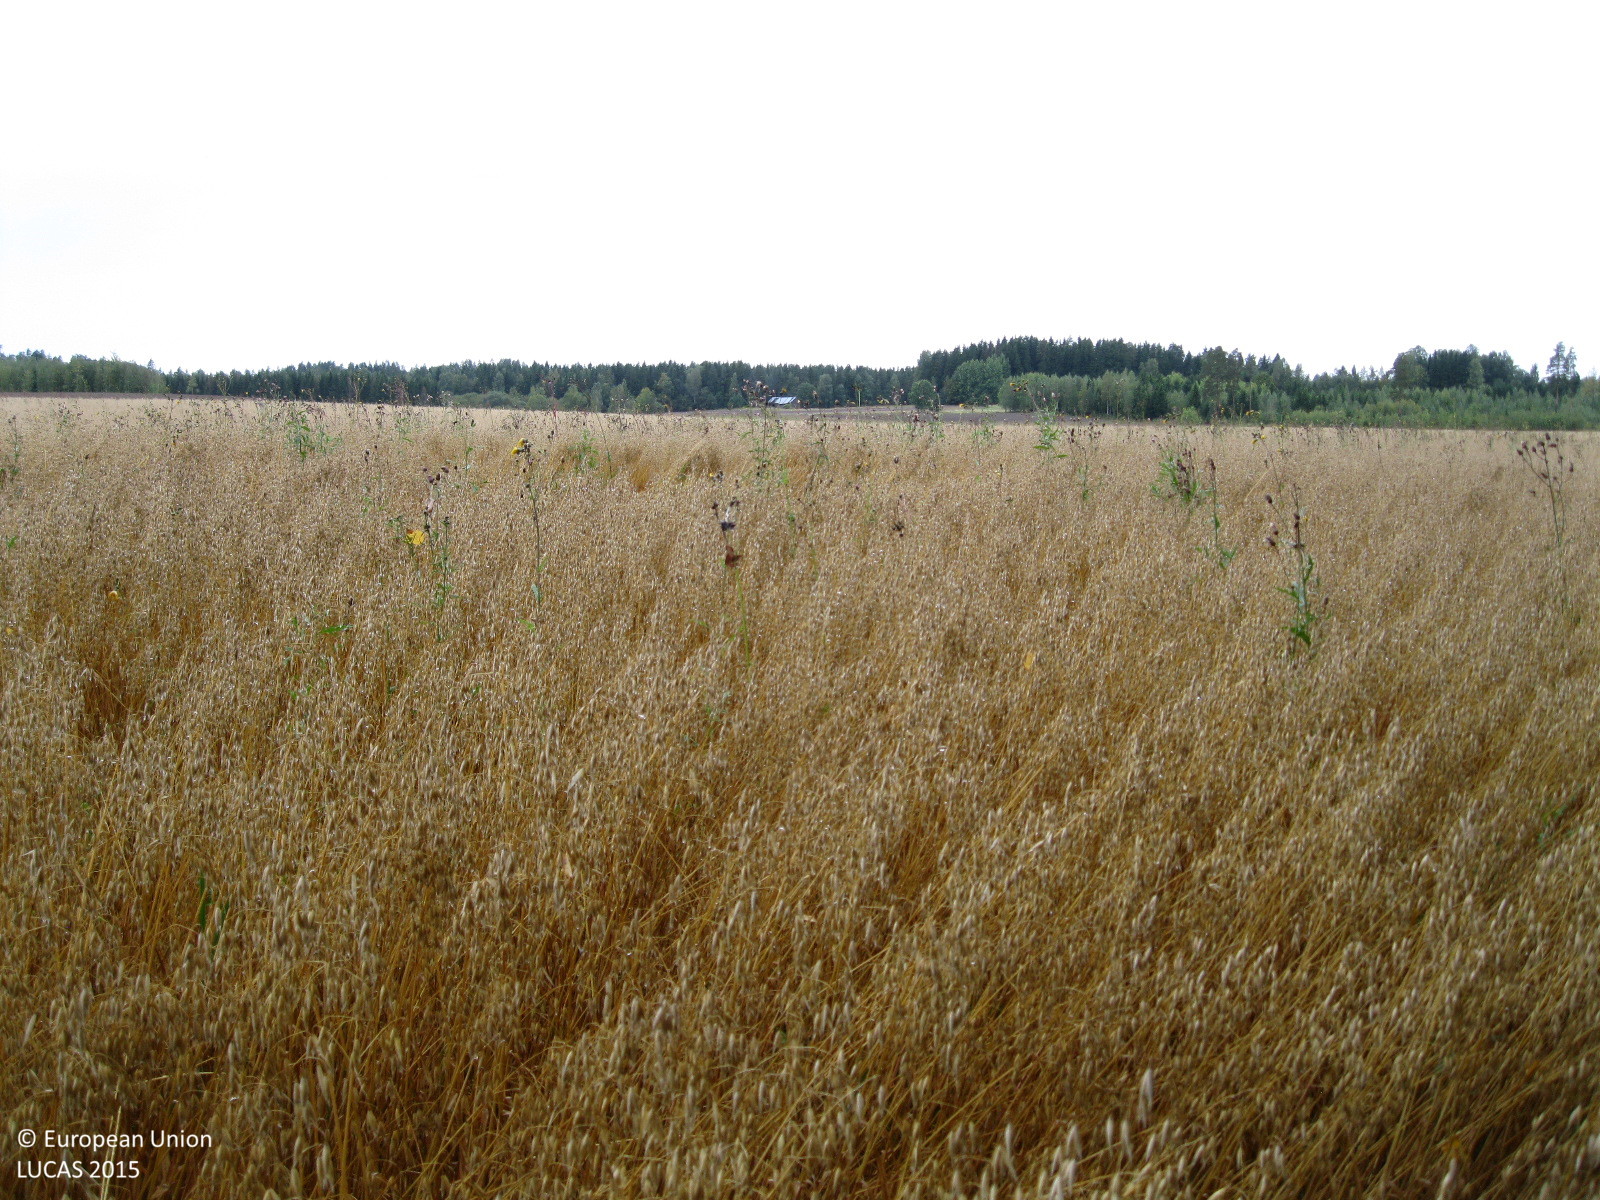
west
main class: Cropland
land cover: Oats
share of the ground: > 75 %
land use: Agriculture (excluding fallow land and kitchen gardens)
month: September
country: FI
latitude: 60.4540
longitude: 24.6724
